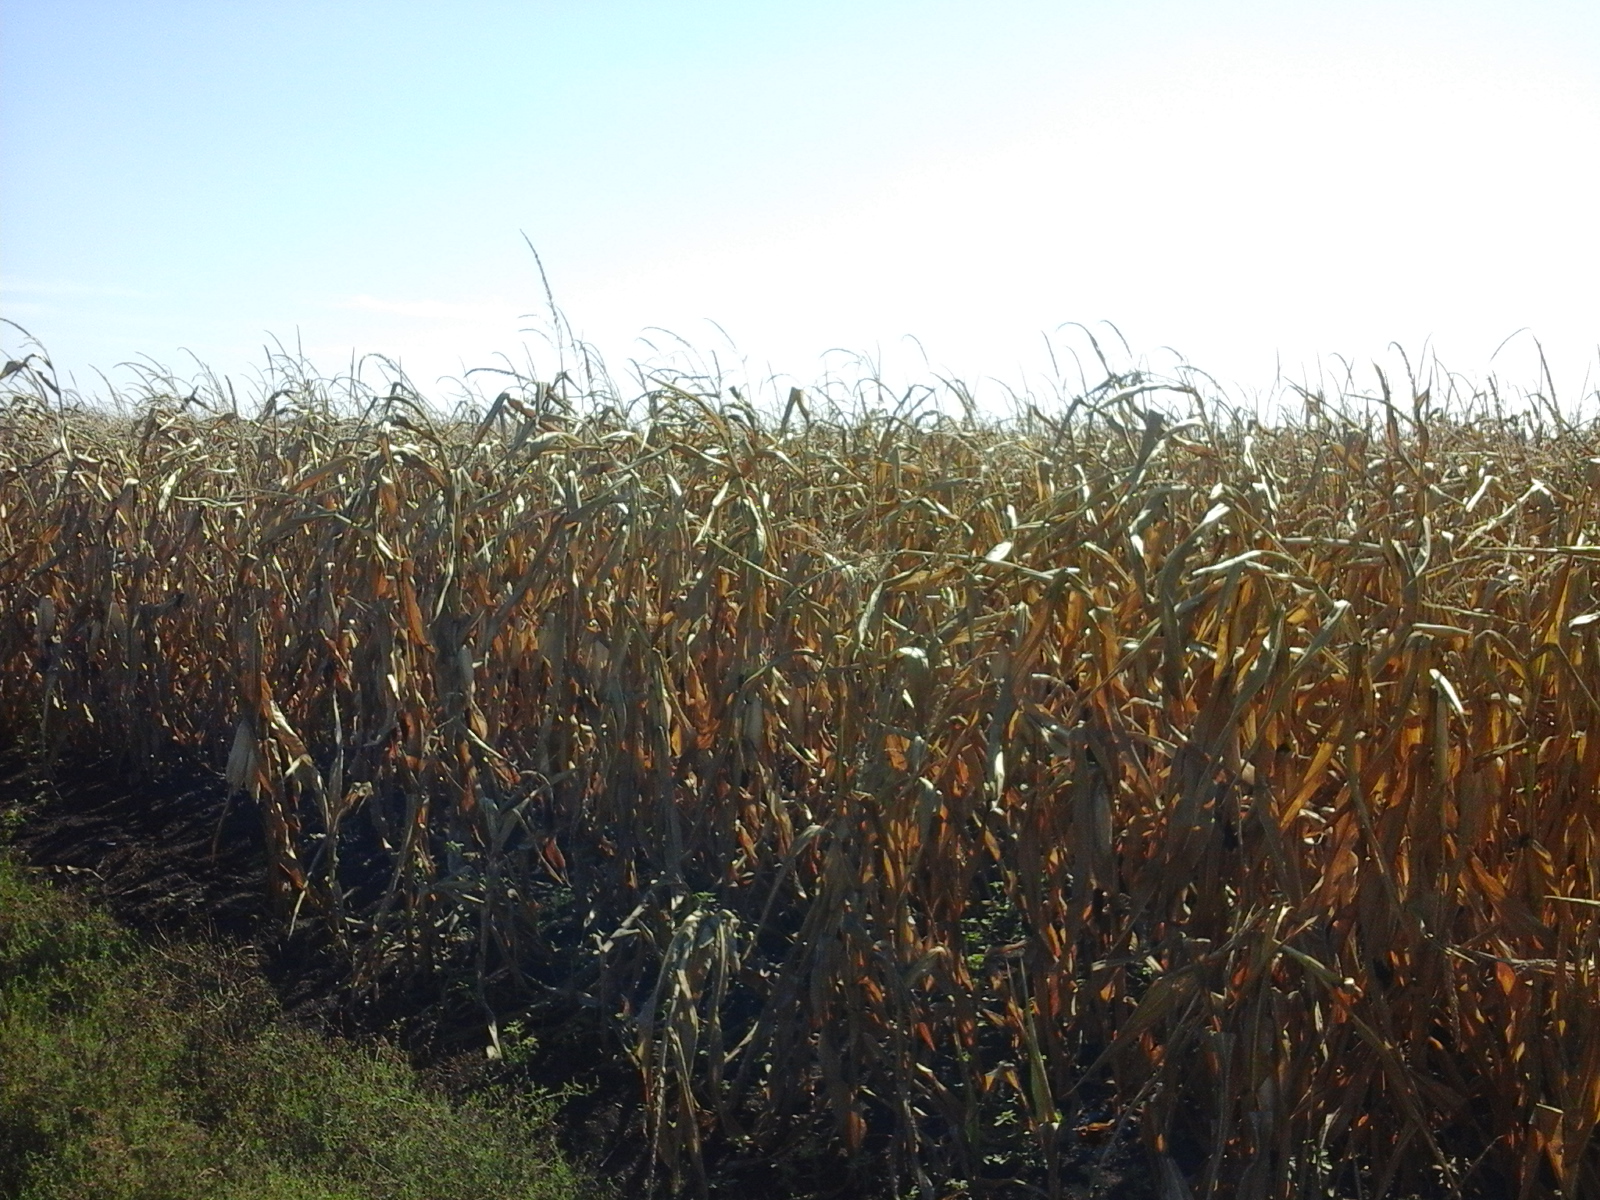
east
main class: Cropland
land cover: Maize
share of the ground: > 75 %
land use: Agriculture (excluding fallow land and kitchen gardens)
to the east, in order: Maize
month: August
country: RO
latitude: 45.8862
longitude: 21.0468
